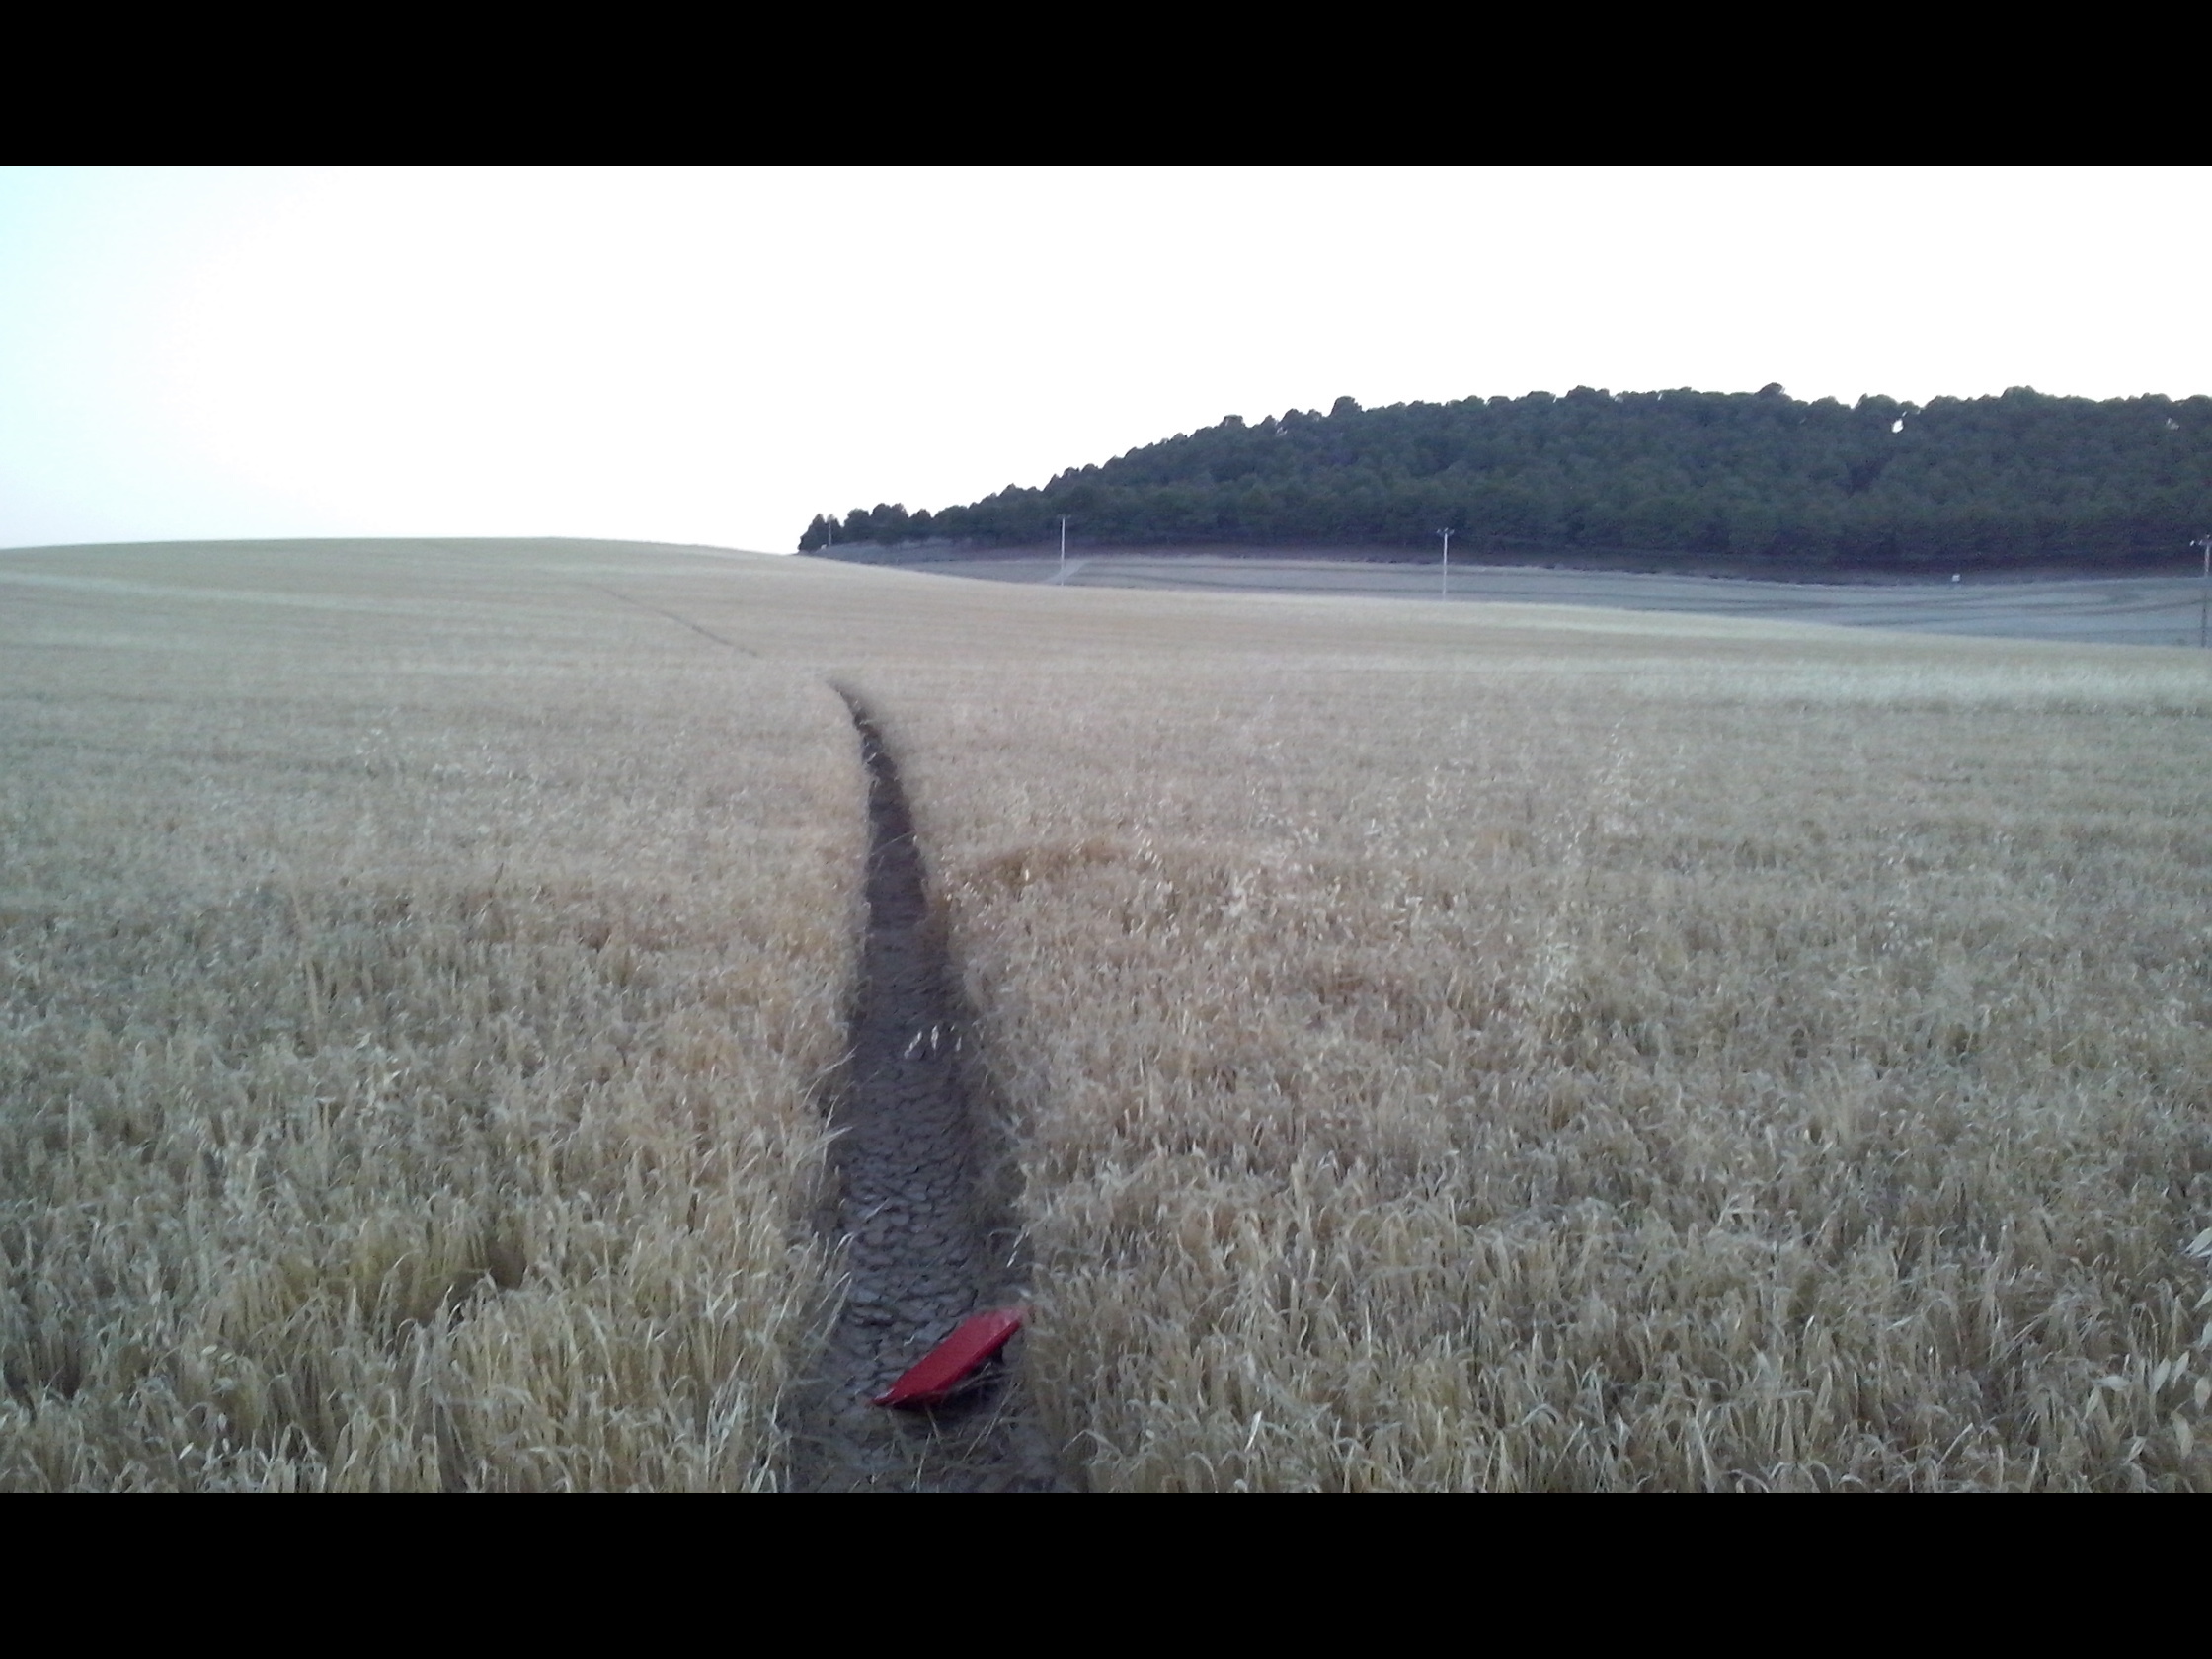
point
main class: Cropland
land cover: Barley
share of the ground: > 75 %
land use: Agriculture (excluding fallow land and kitchen gardens)
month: June
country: ES
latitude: 41.5938
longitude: -5.1806
